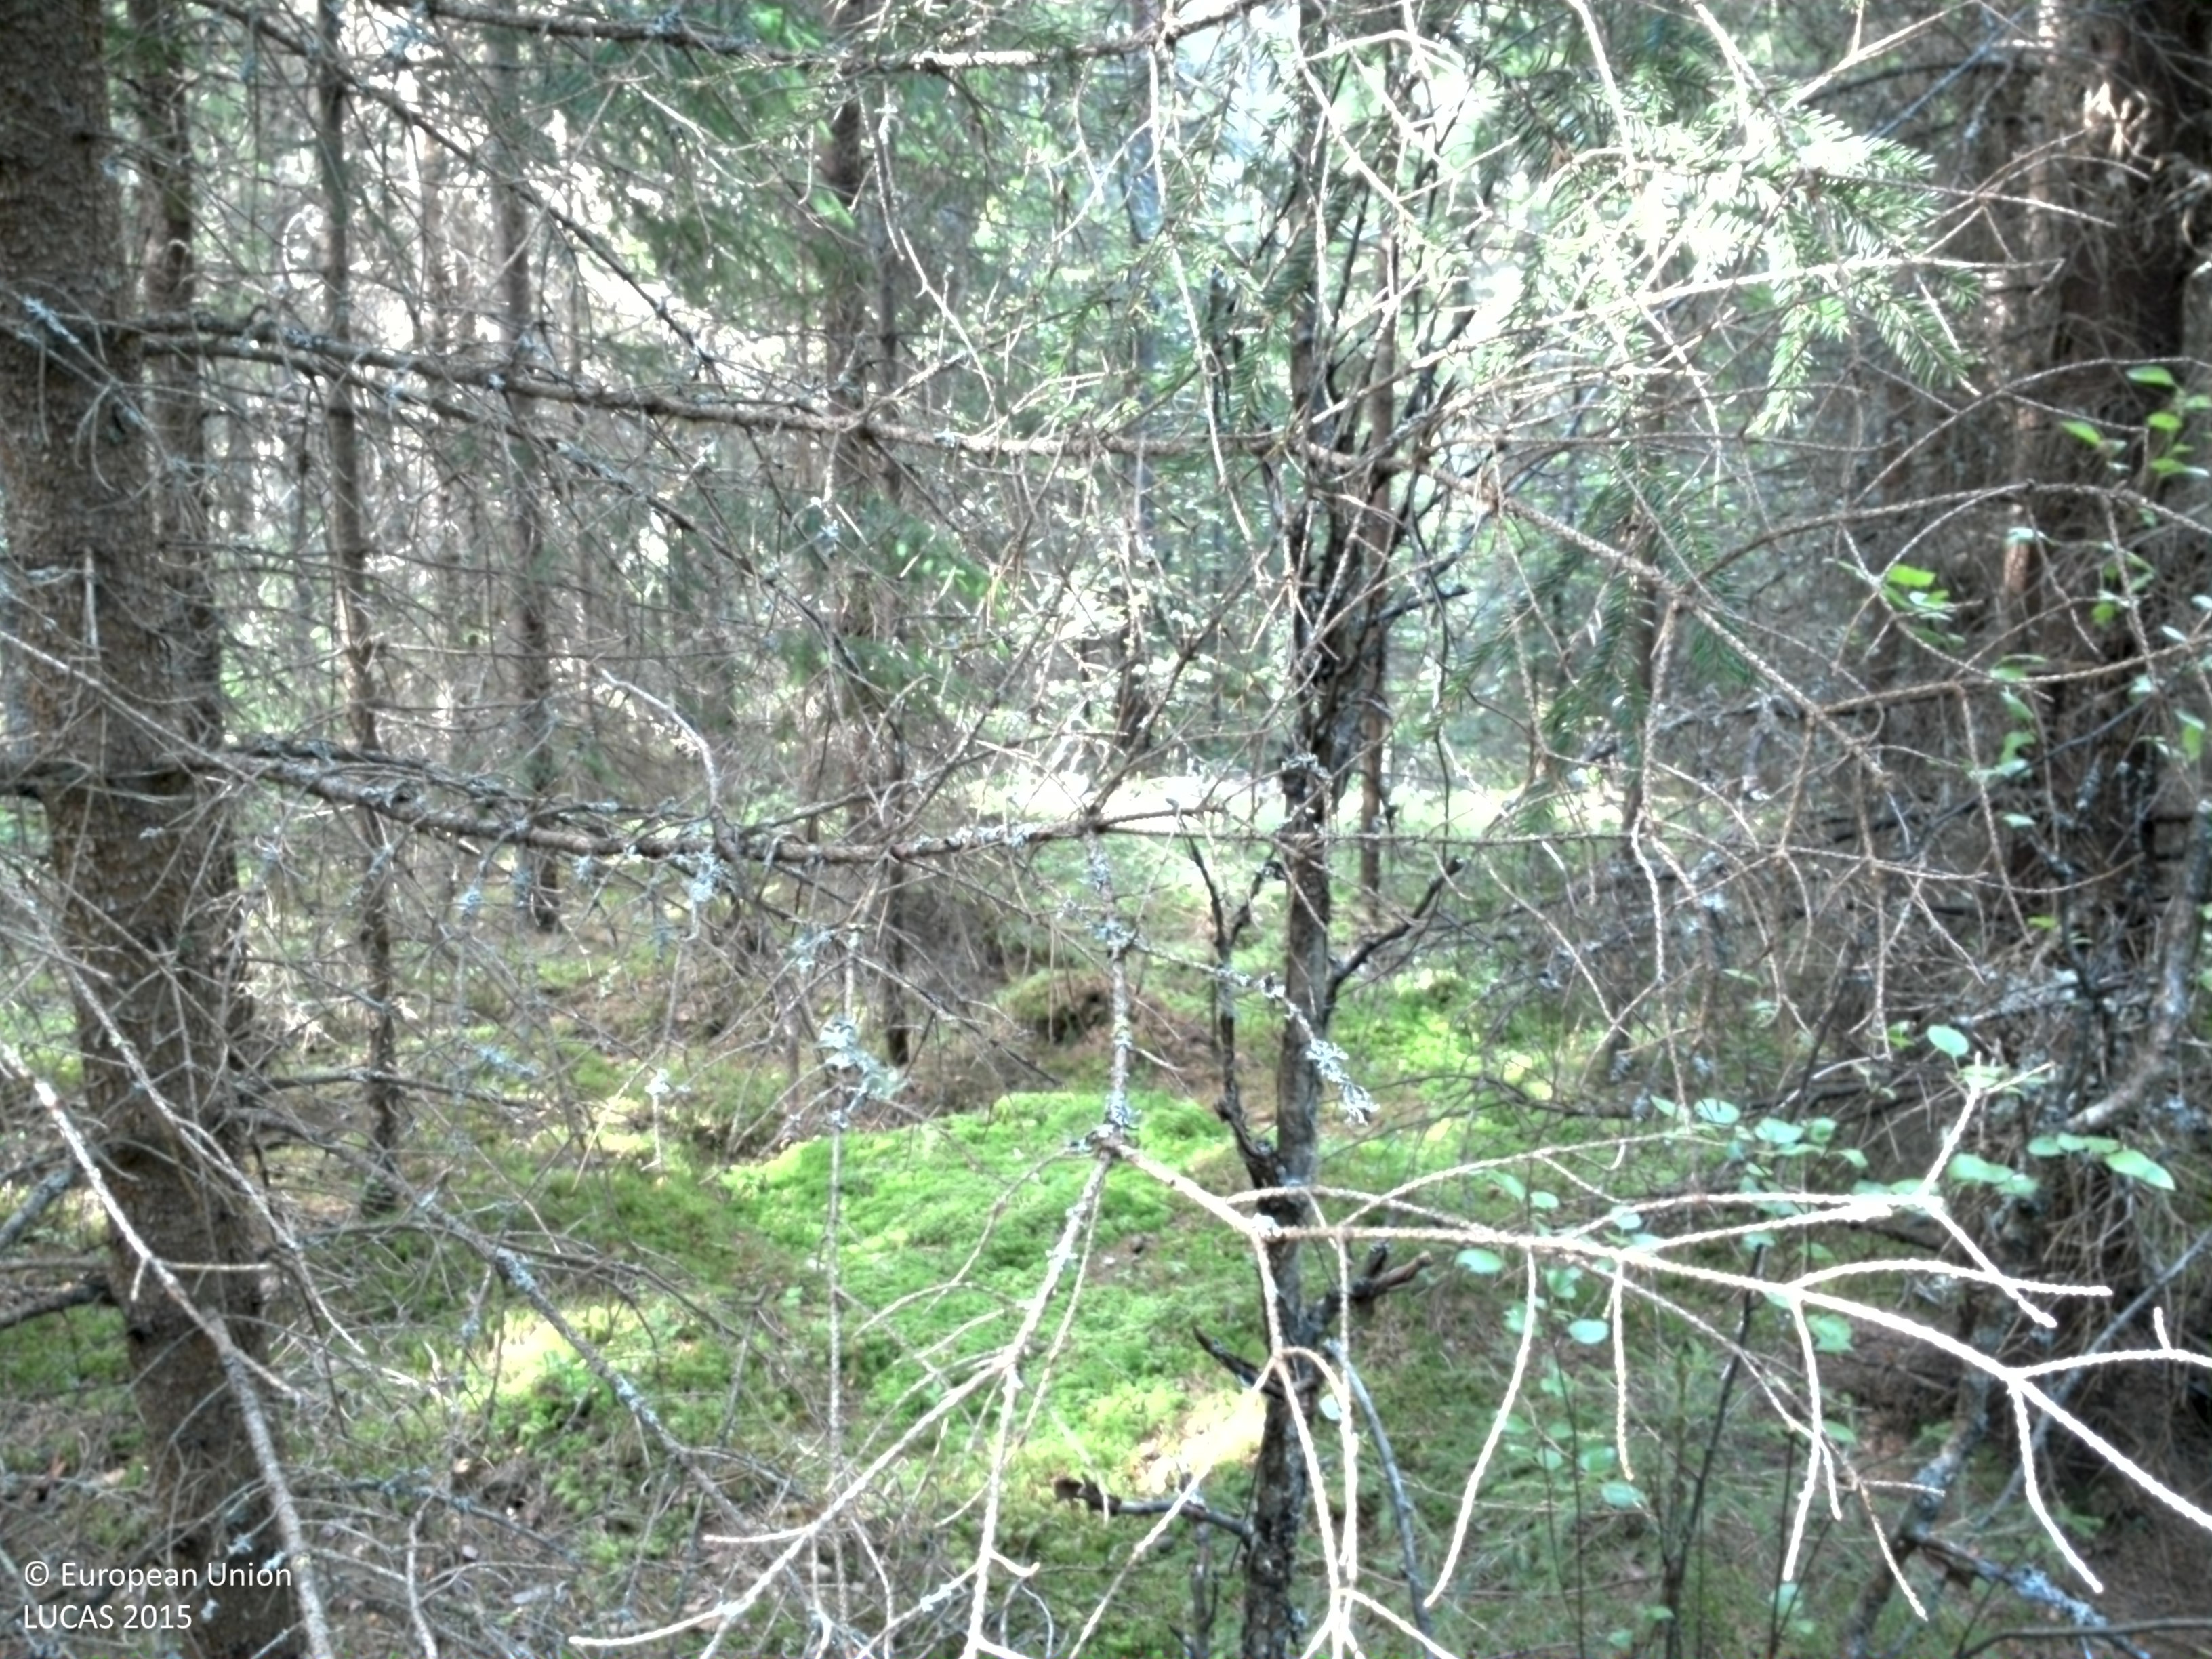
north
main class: Woodland
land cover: Spruce dominated coniferous woodland
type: boreal forest
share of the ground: > 75 %
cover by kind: coniferous forest trees 75 %, lichens and mosses 15 %, broadleaved forest trees 5 %, herbaceous plants 5 %
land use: Forestry
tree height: > 5 m
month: June
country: SE
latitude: 59.5778
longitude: 14.1871
